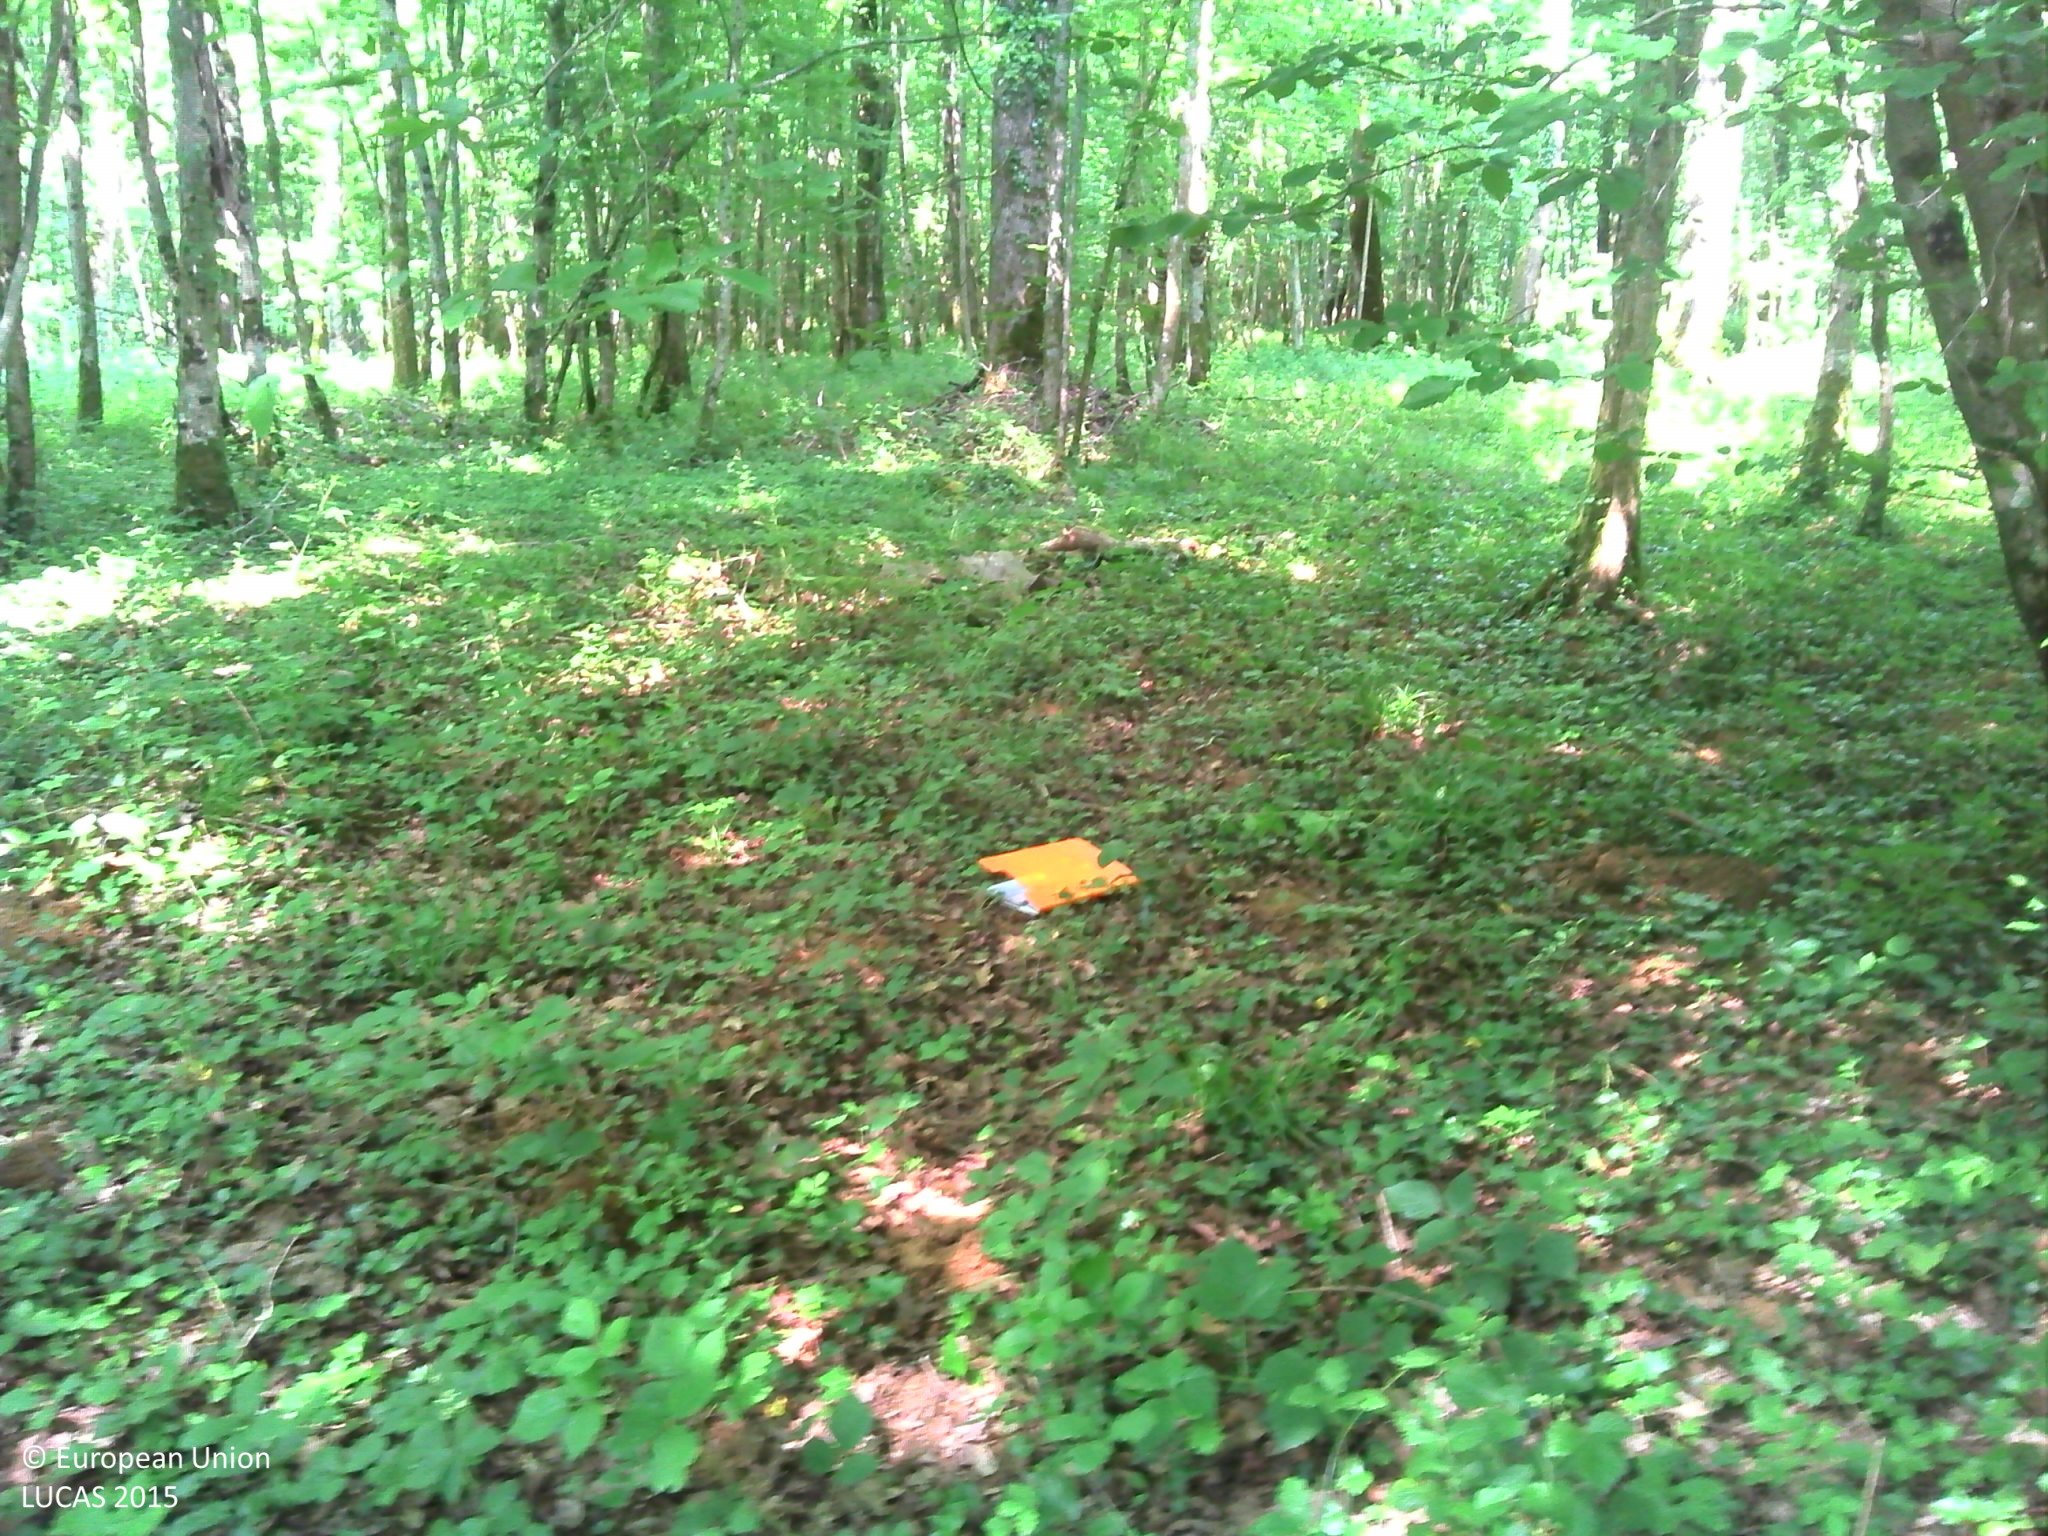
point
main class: Woodland
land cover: Broadleaved woodland
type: beech forest
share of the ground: > 75 %
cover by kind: broadleaved forest trees 95 %, herbaceous plants 5 %
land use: Forestry
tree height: > 5 m
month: June
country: FR
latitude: 47.5667
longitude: 6.2930
